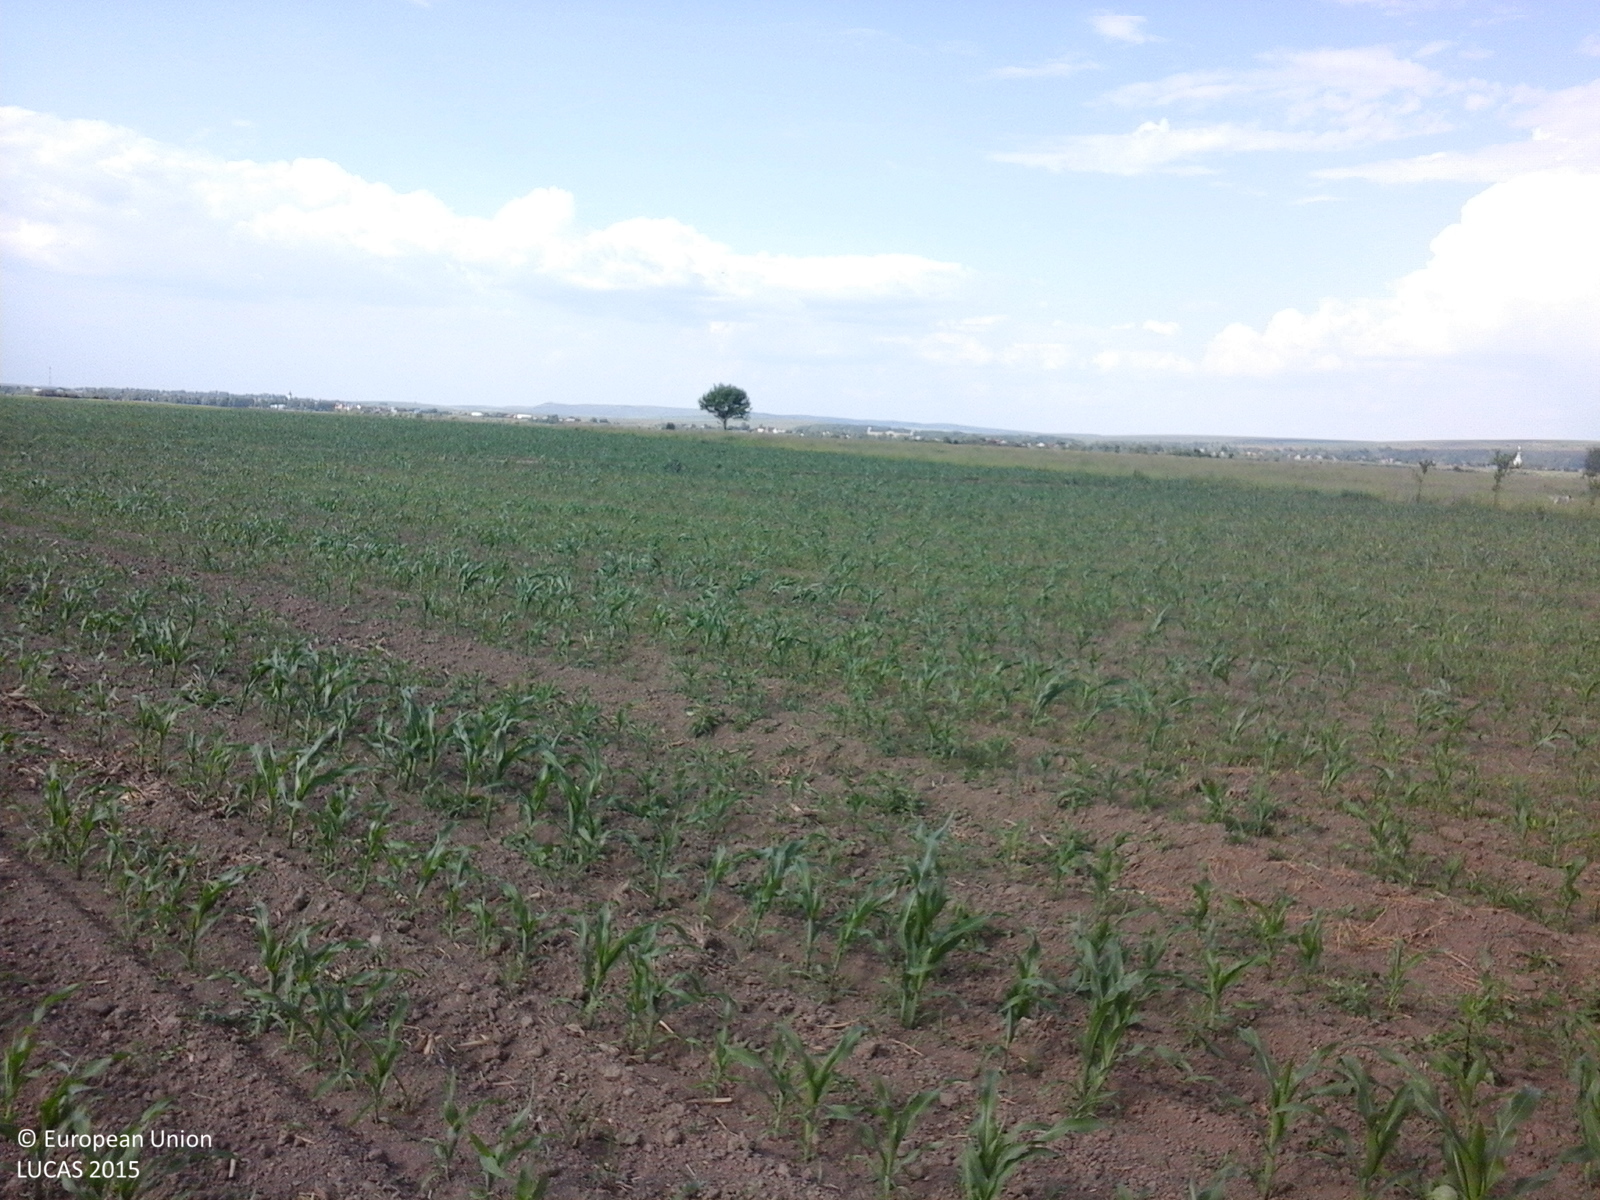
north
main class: Cropland
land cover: Maize
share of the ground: 10 - 25 %
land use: Agriculture (excluding fallow land and kitchen gardens)
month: June
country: RO
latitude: 46.7736
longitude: 26.5739
